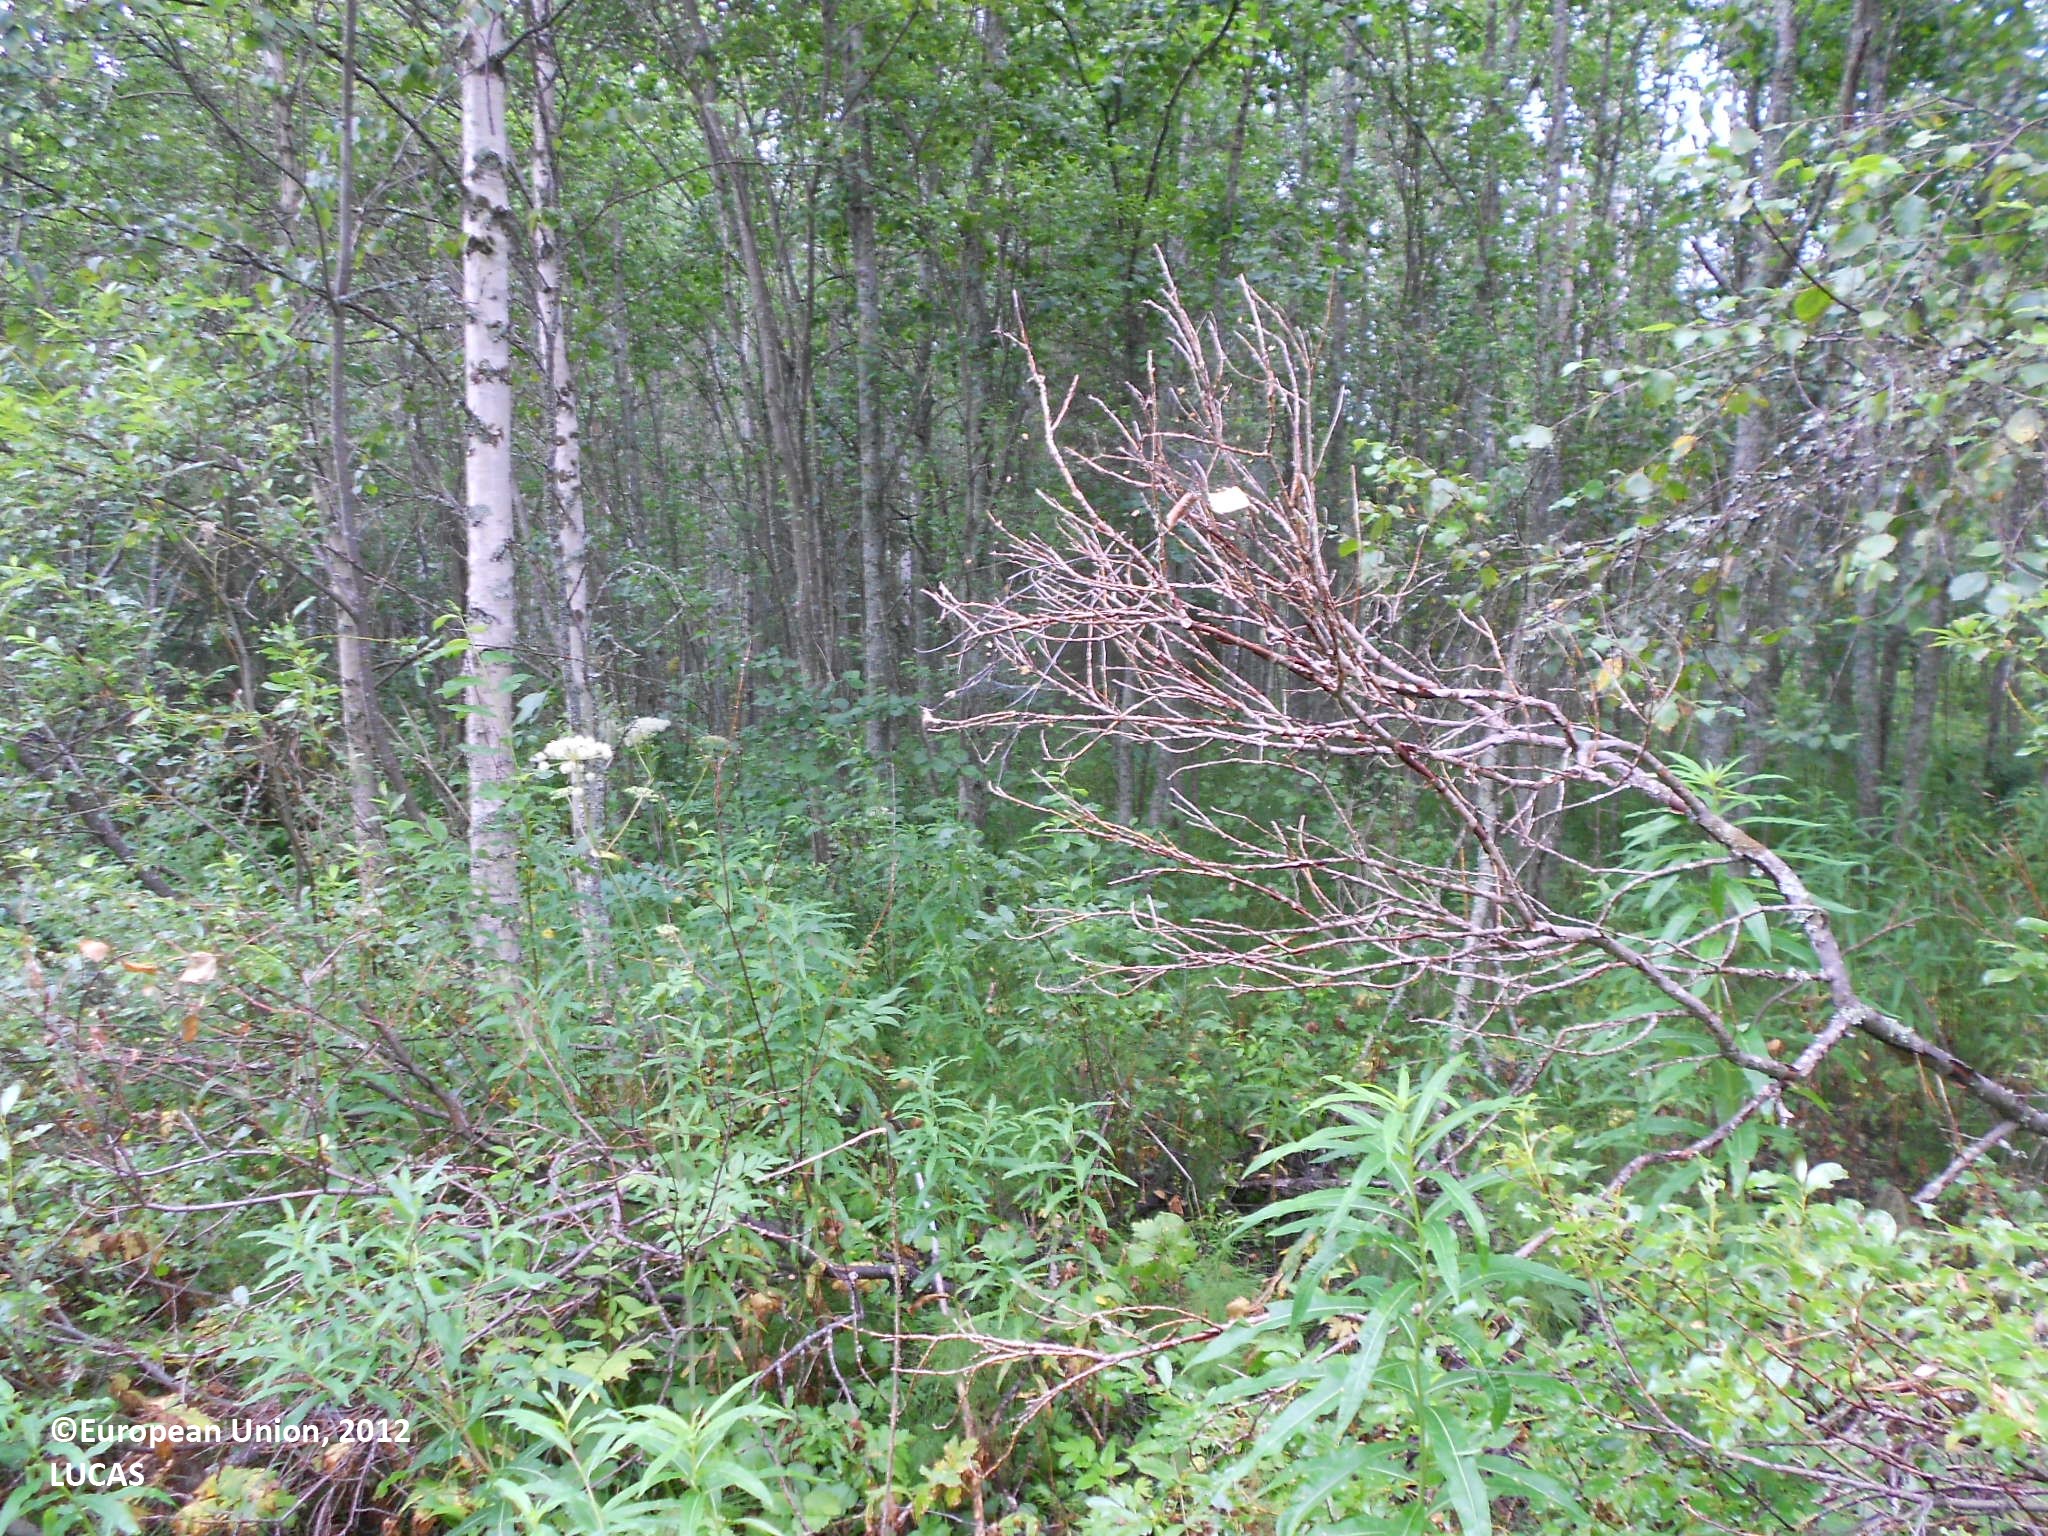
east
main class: Woodland
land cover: Broadleaved woodland
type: boreal forest
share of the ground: 50 - 75 %
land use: Forestry
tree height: > 5 m
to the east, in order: Broadleaved woodland; Pine dominated mixed woodland; Rivers and streams; Broadleaved woodland; Spruce dominated coniferous woodland; Pine dominated mixed woodland; Spruce dominated coniferous woodland
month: August
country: FI
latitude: 63.5050
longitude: 28.9092
